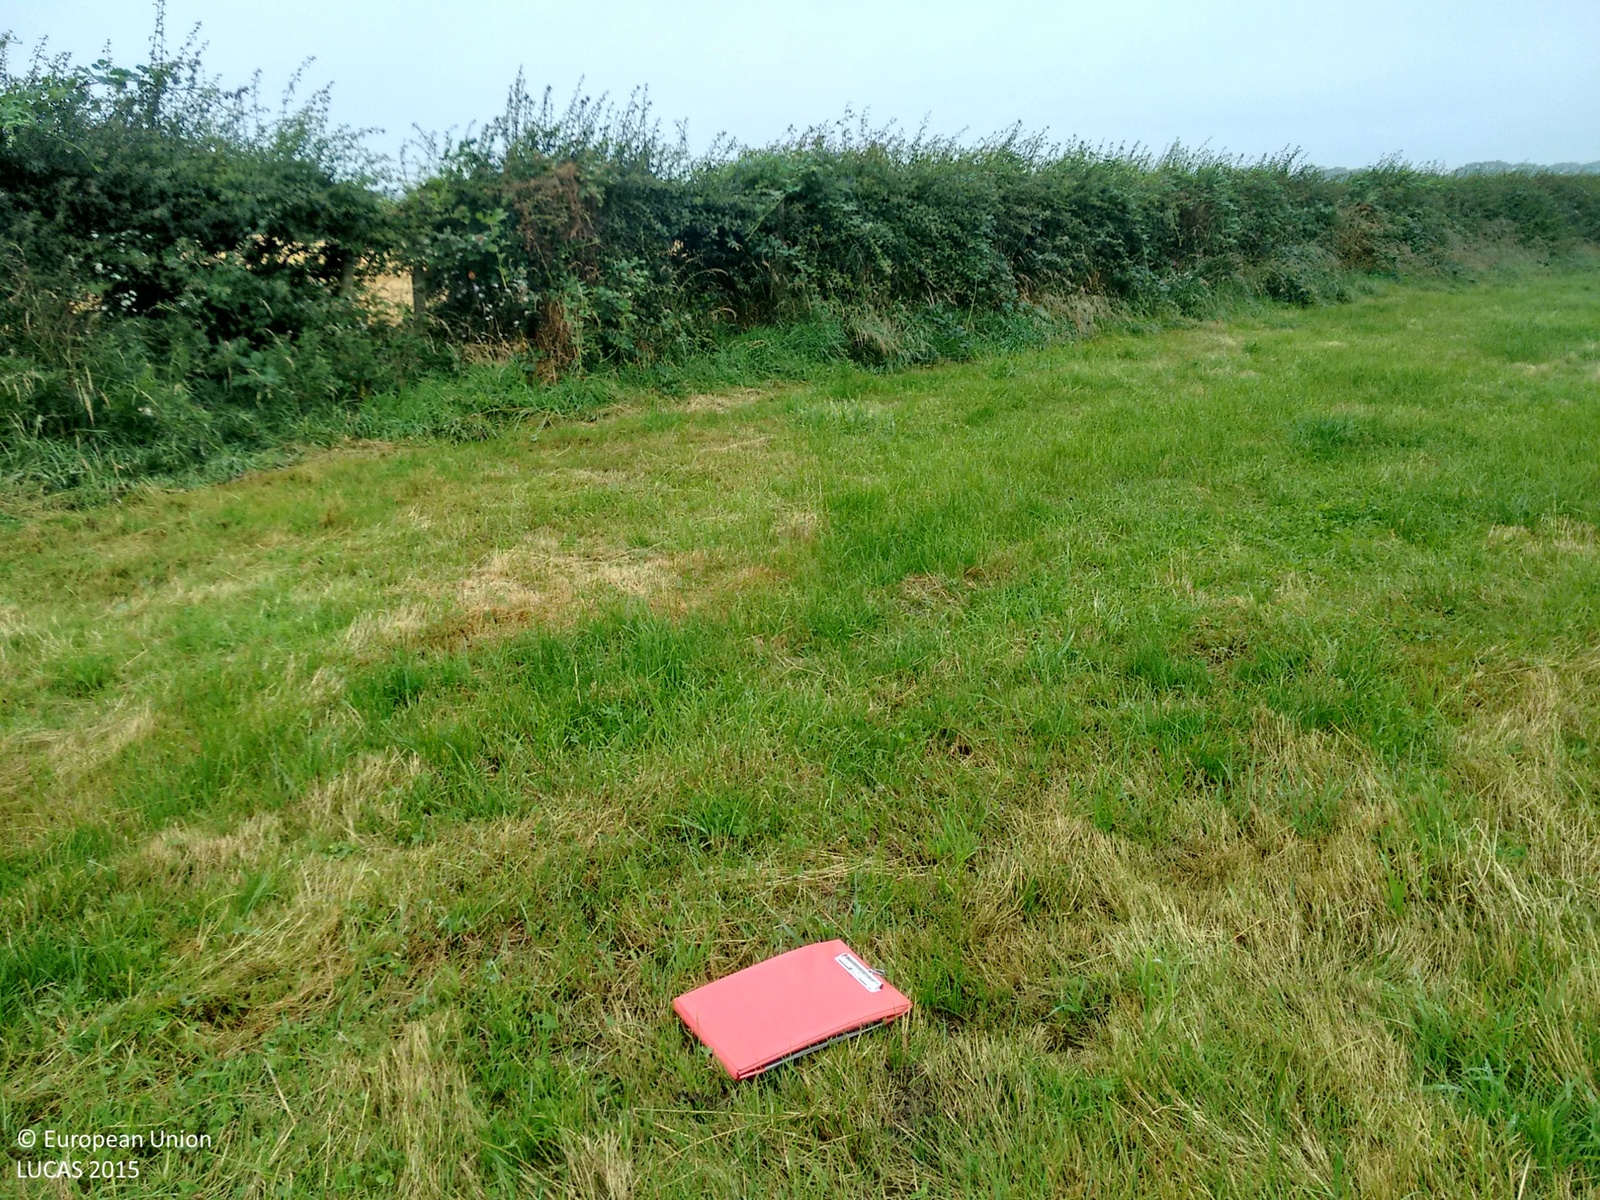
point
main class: Grassland
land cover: Grassland without tree/shrub cover
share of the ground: > 75 %
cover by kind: herbaceous plants 100 %
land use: Agriculture (excluding fallow land and kitchen gardens)
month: August
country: GB
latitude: 54.2852
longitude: -5.6304
